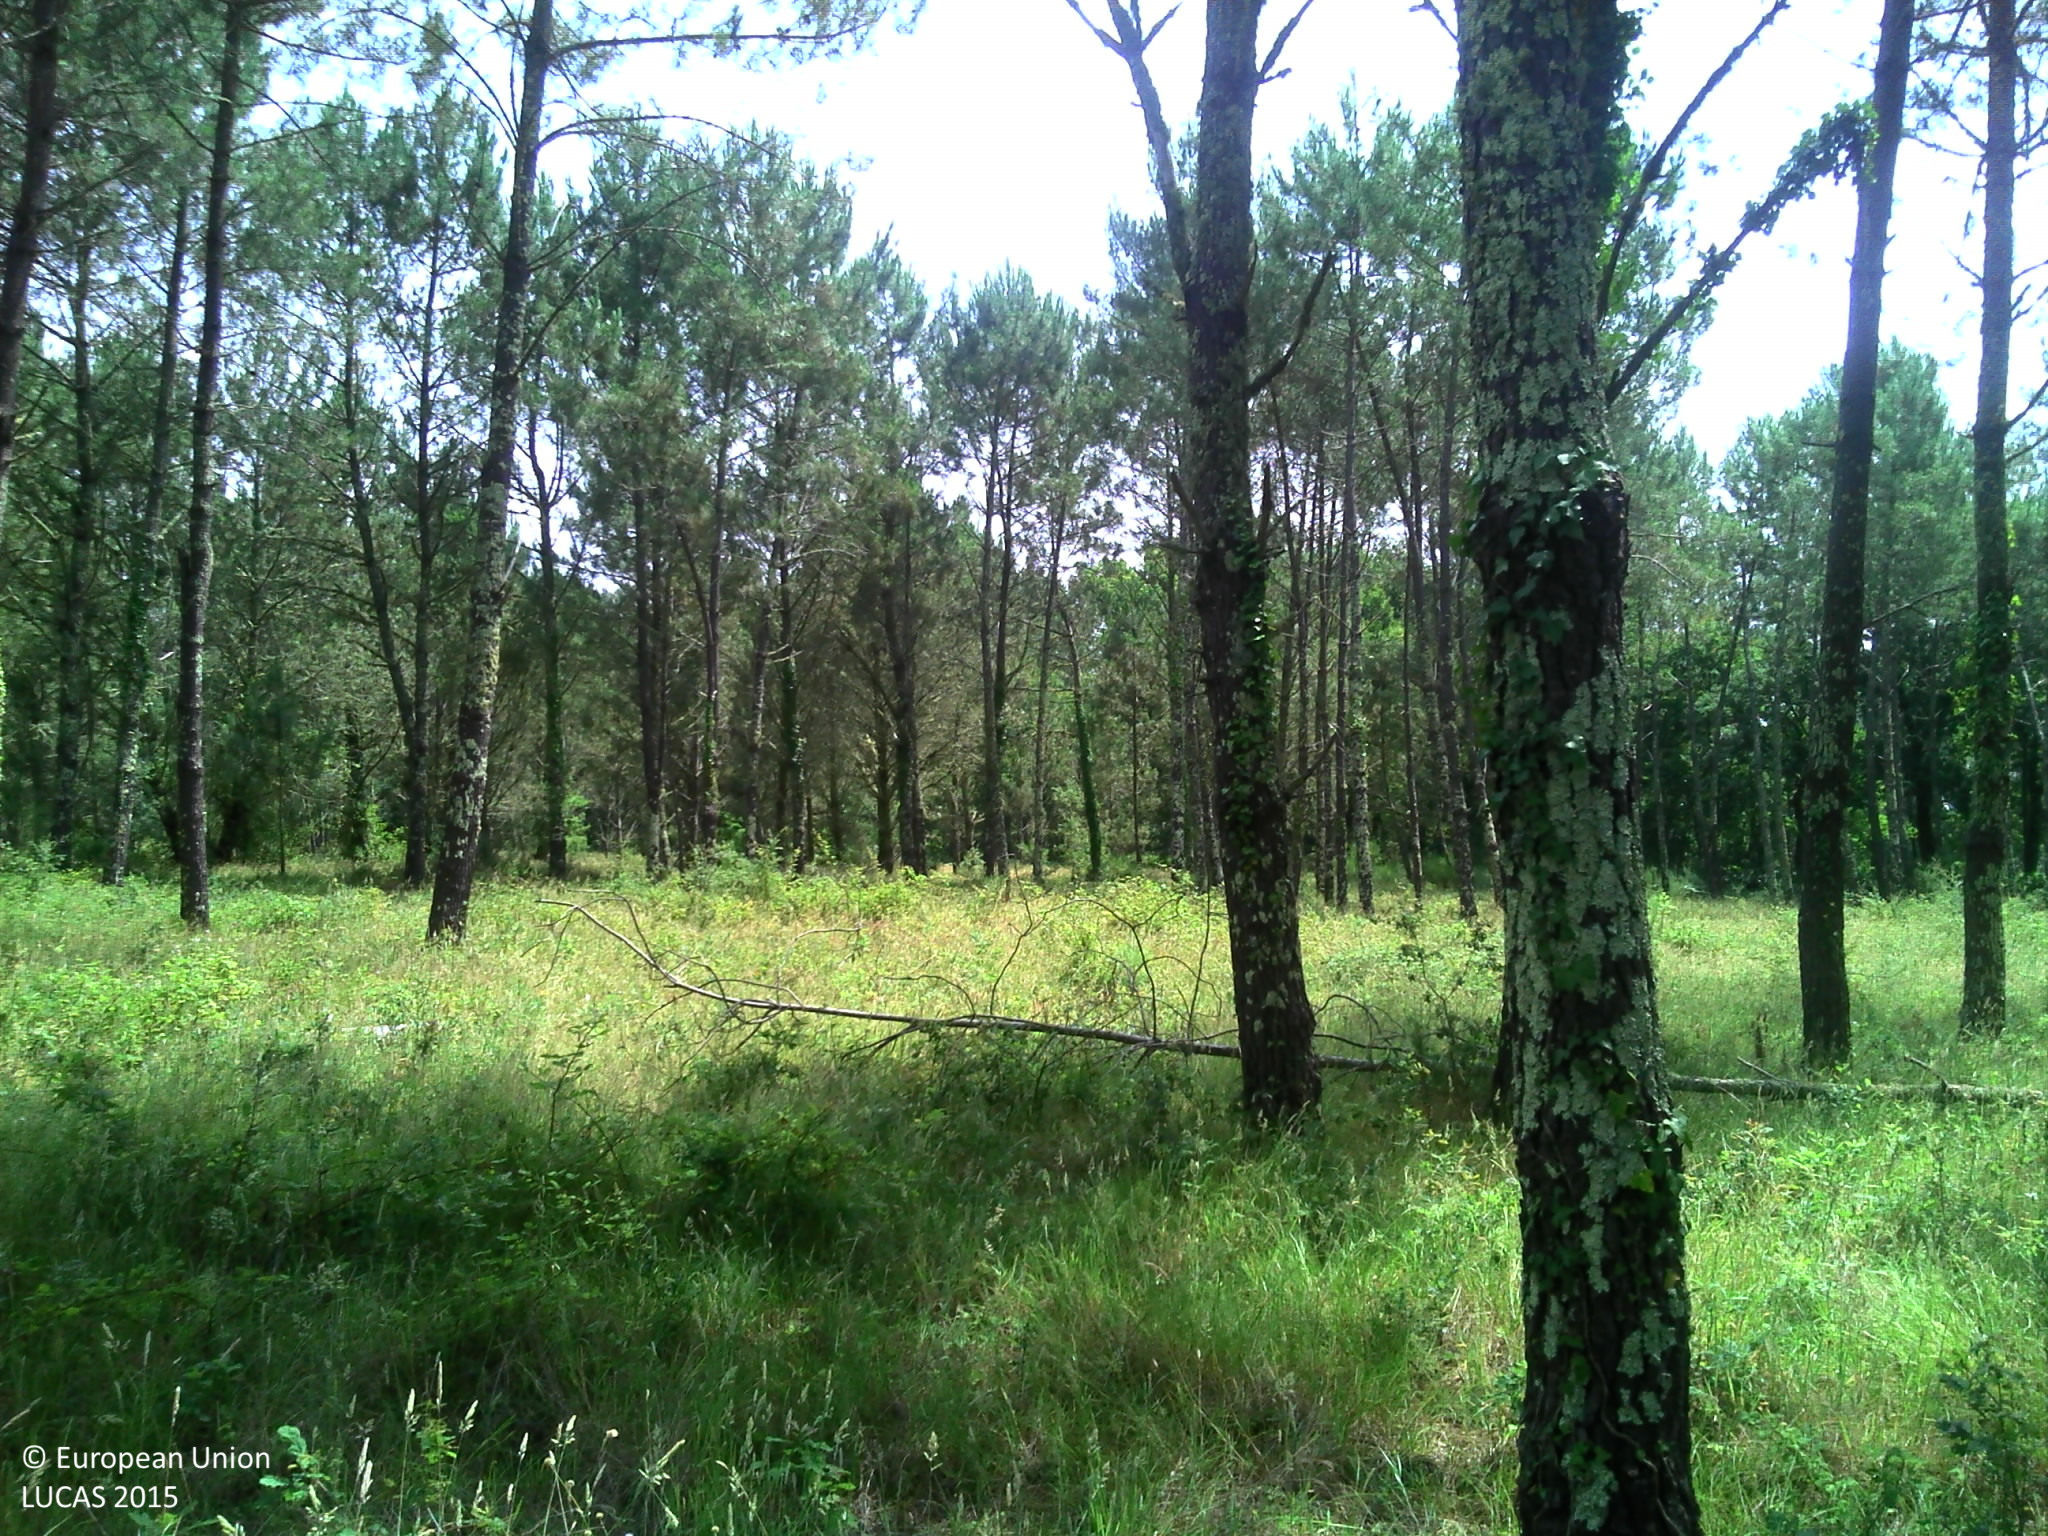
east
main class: Woodland
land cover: Pine dominated coniferous woodland
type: coniferous forest of the mediterranean region
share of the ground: > 75 %
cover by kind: coniferous forest trees 90 %, broadleaved forest trees 5 %, herbaceous plants 5 %
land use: Forestry
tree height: > 5 m
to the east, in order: Pine dominated coniferous woodland; Broadleaved woodland; Spontaneously vegetated surfaces; Pine dominated mixed woodland; Electric lines; Ditches and canals; Grass margins; Paved roads, cycling and walking lanes; Grass margins; Ditches and canals; Electric lines; Pine dominated coniferous woodland; Tracks; Pine dominated coniferous woodland
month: July
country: FR
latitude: 43.8048
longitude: -1.2929
